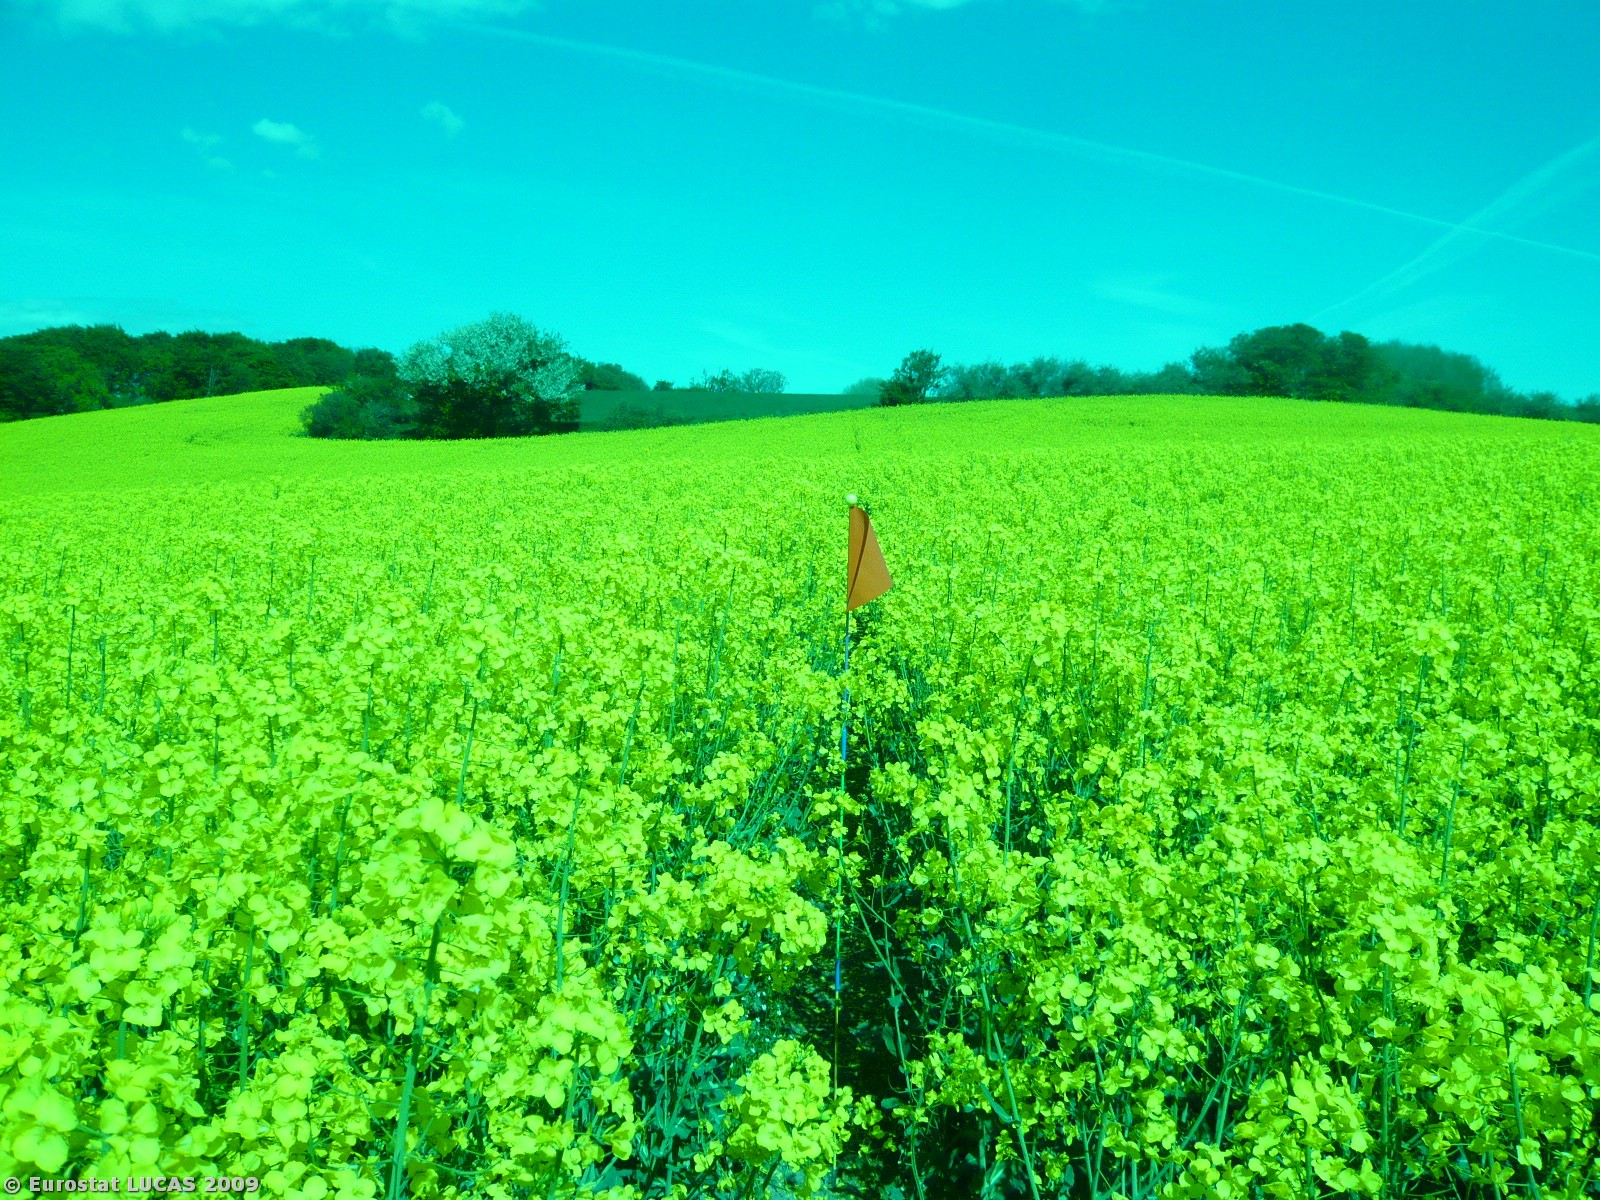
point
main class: Cropland
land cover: Rape and turnip rape
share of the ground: > 75 %
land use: Agriculture (excluding fallow land and kitchen gardens)
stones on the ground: < 10 %
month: May
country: DK
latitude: 55.0037
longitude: 11.9842
